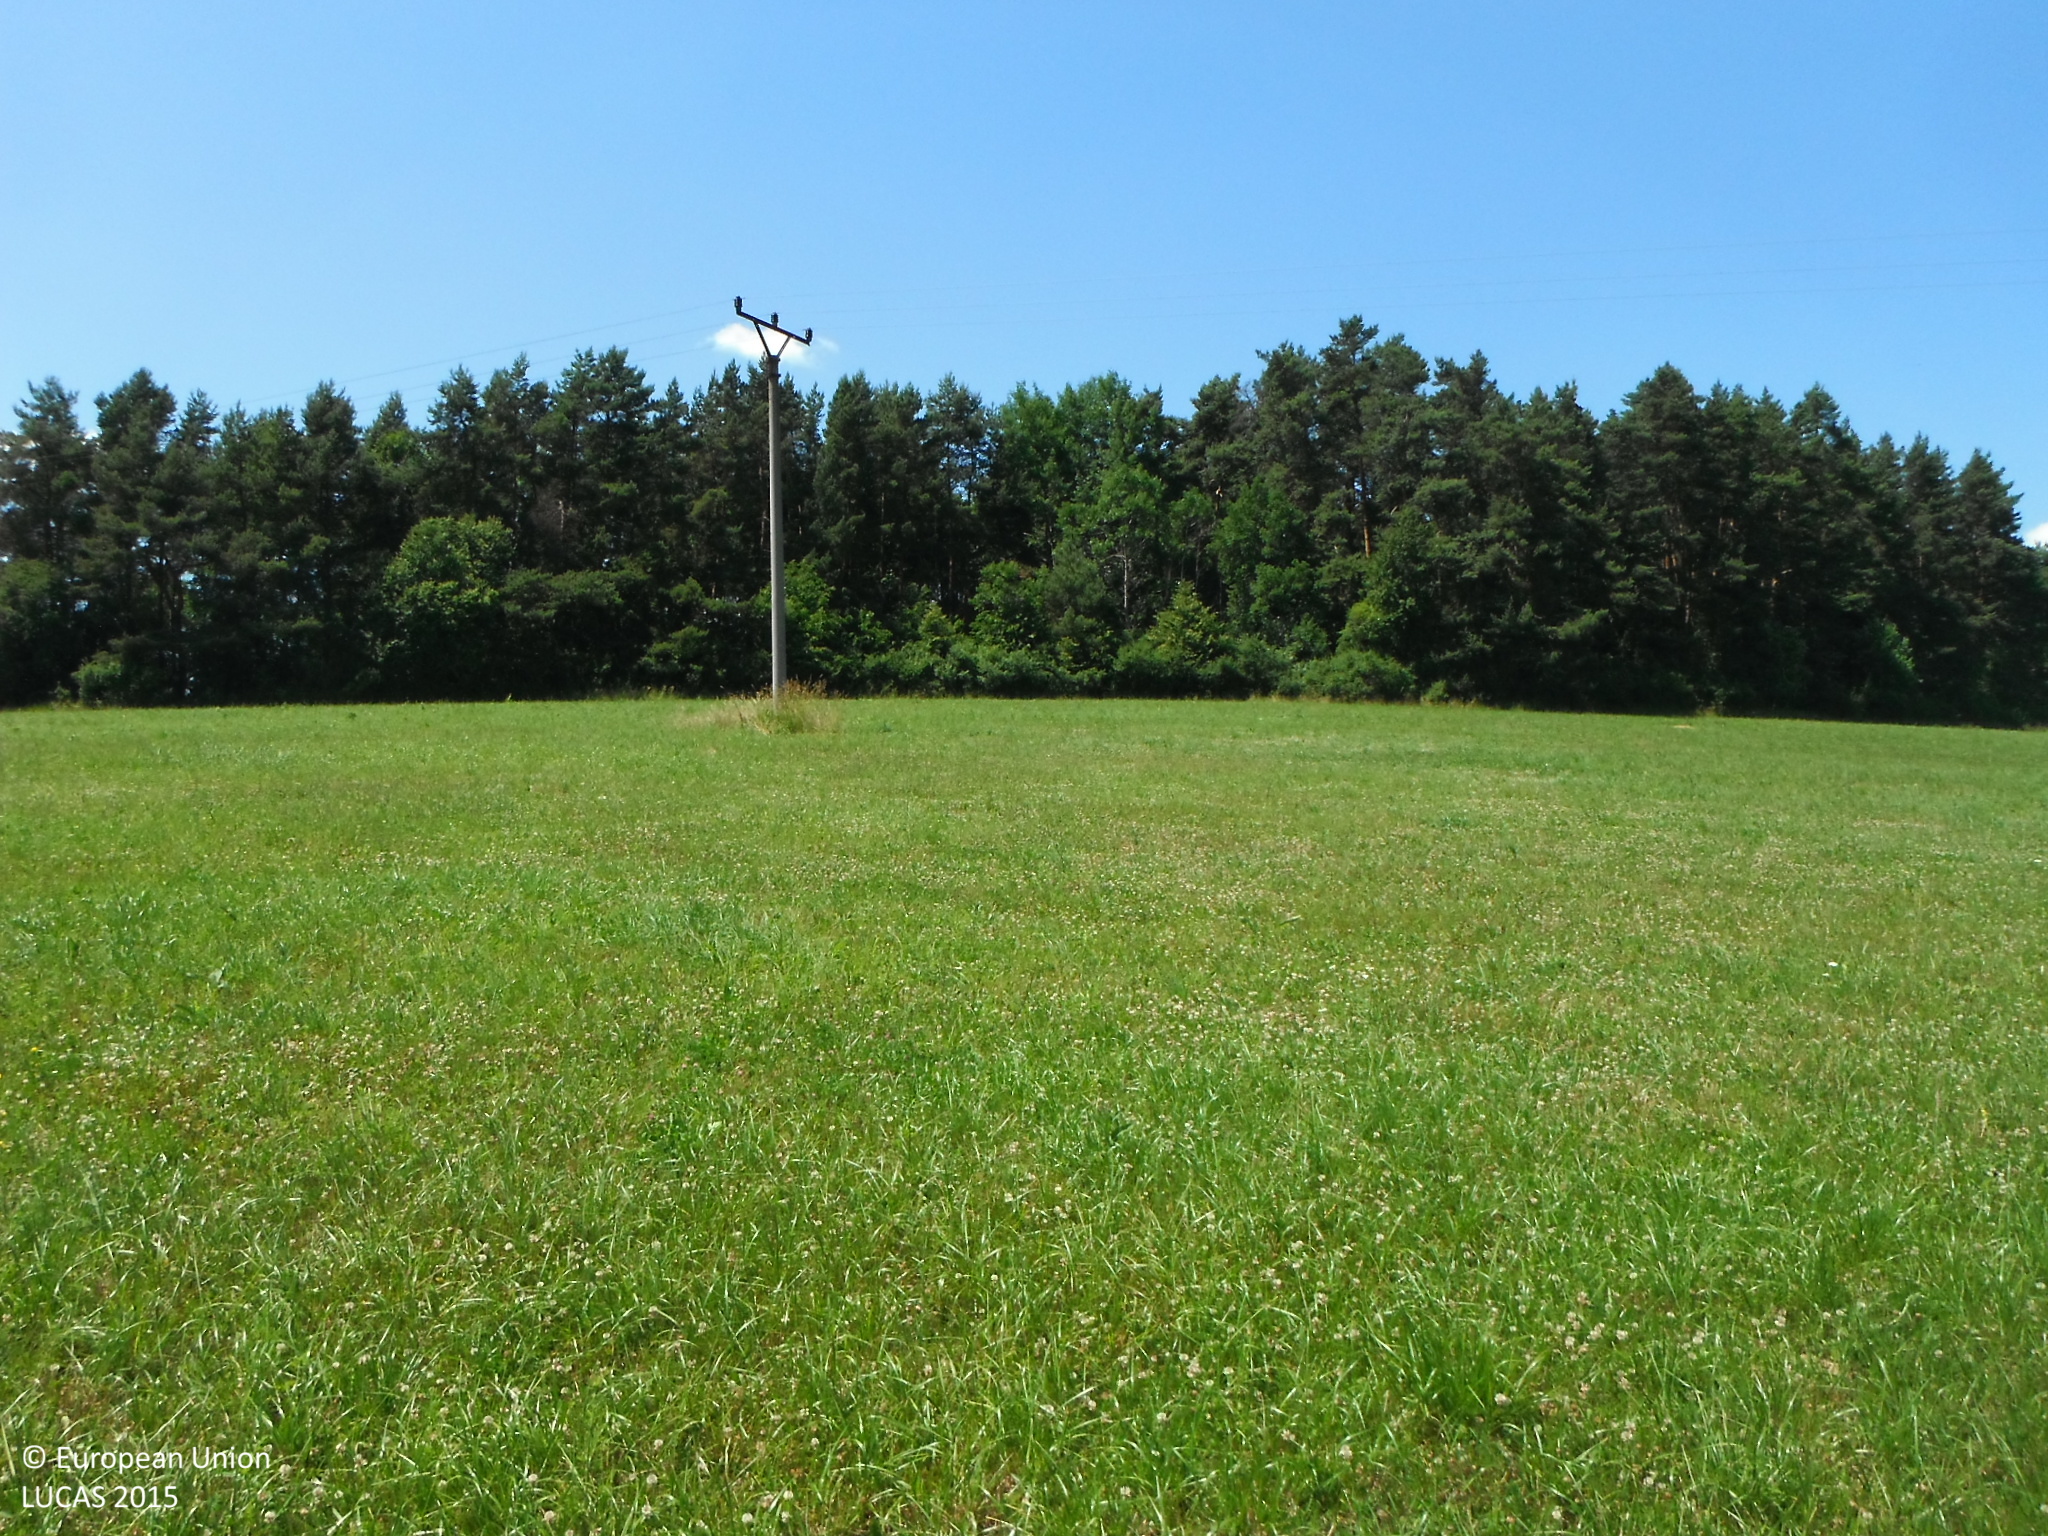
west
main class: Grassland
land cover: Grassland without tree/shrub cover
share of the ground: > 75 %
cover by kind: herbaceous plants 100 %
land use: Agriculture (excluding fallow land and kitchen gardens)
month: July
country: SK
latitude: 48.9682
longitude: 20.7346
